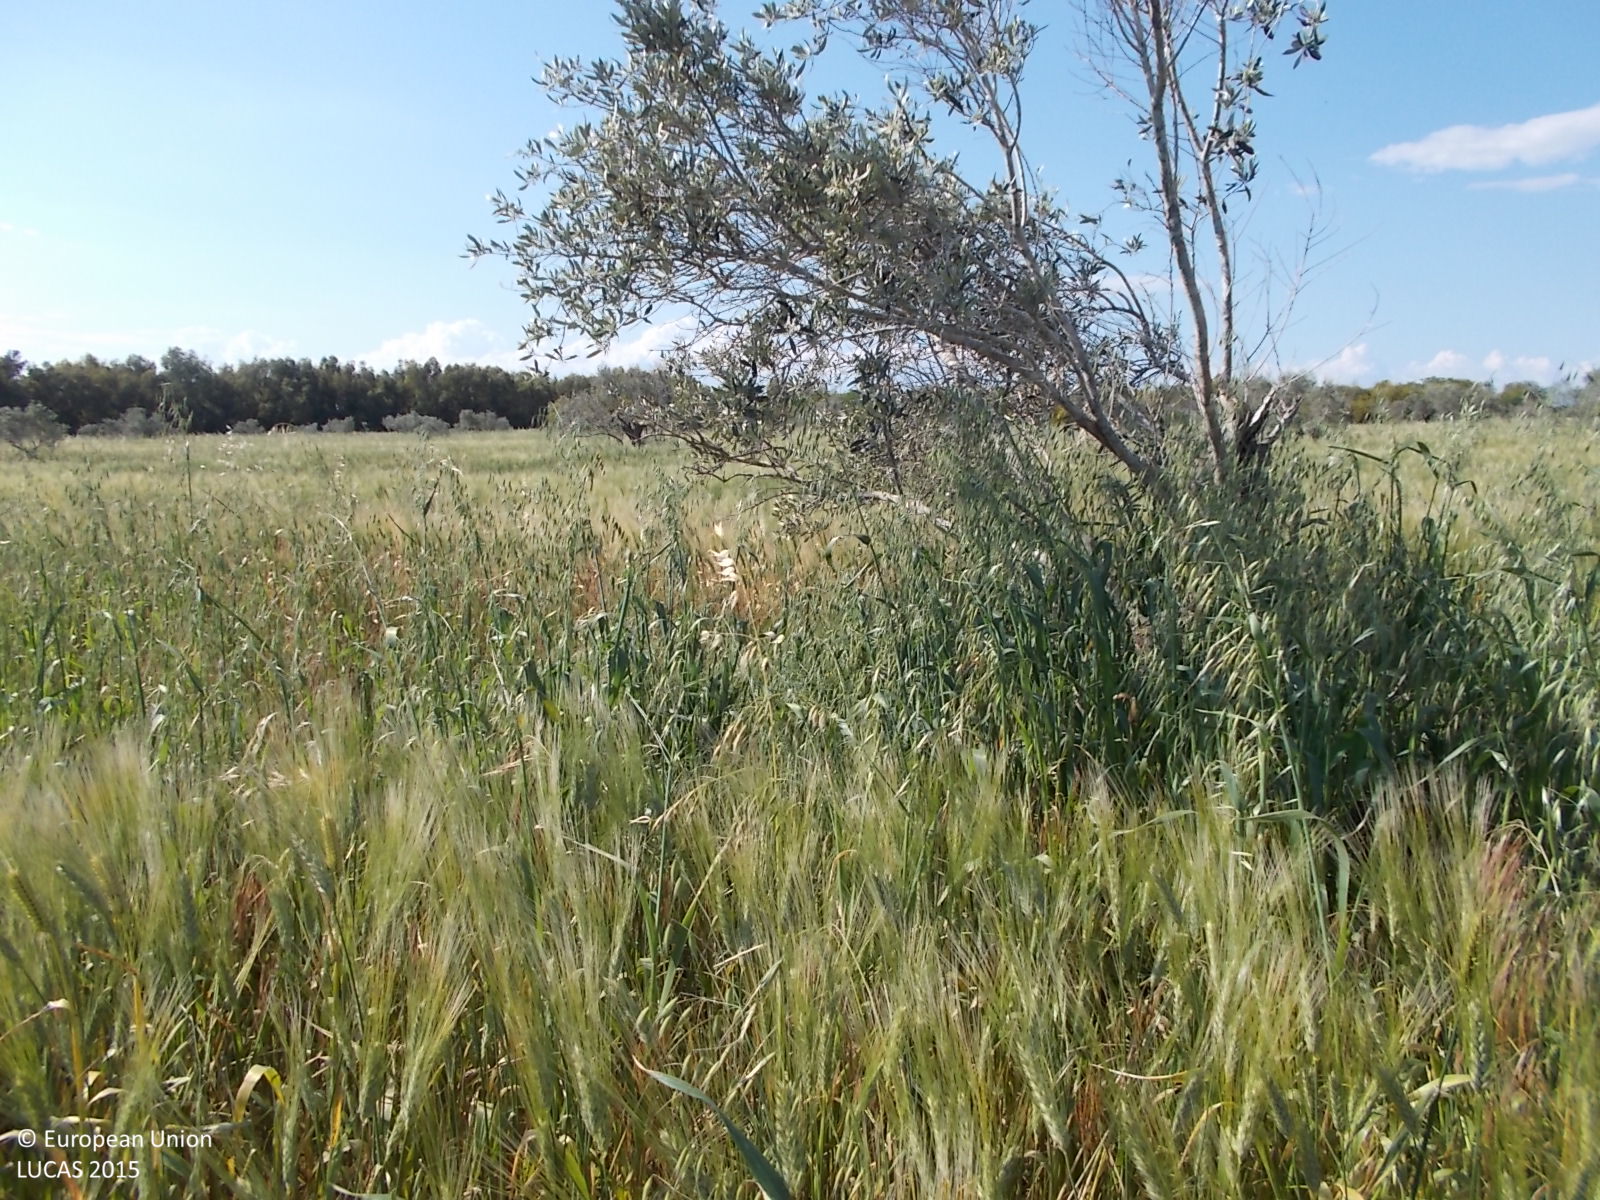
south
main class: Cropland
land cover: Mixed cereals for fodder
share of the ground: > 75 %
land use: Agriculture (excluding fallow land and kitchen gardens)
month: April
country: CY
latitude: 34.8431
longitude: 33.6068
